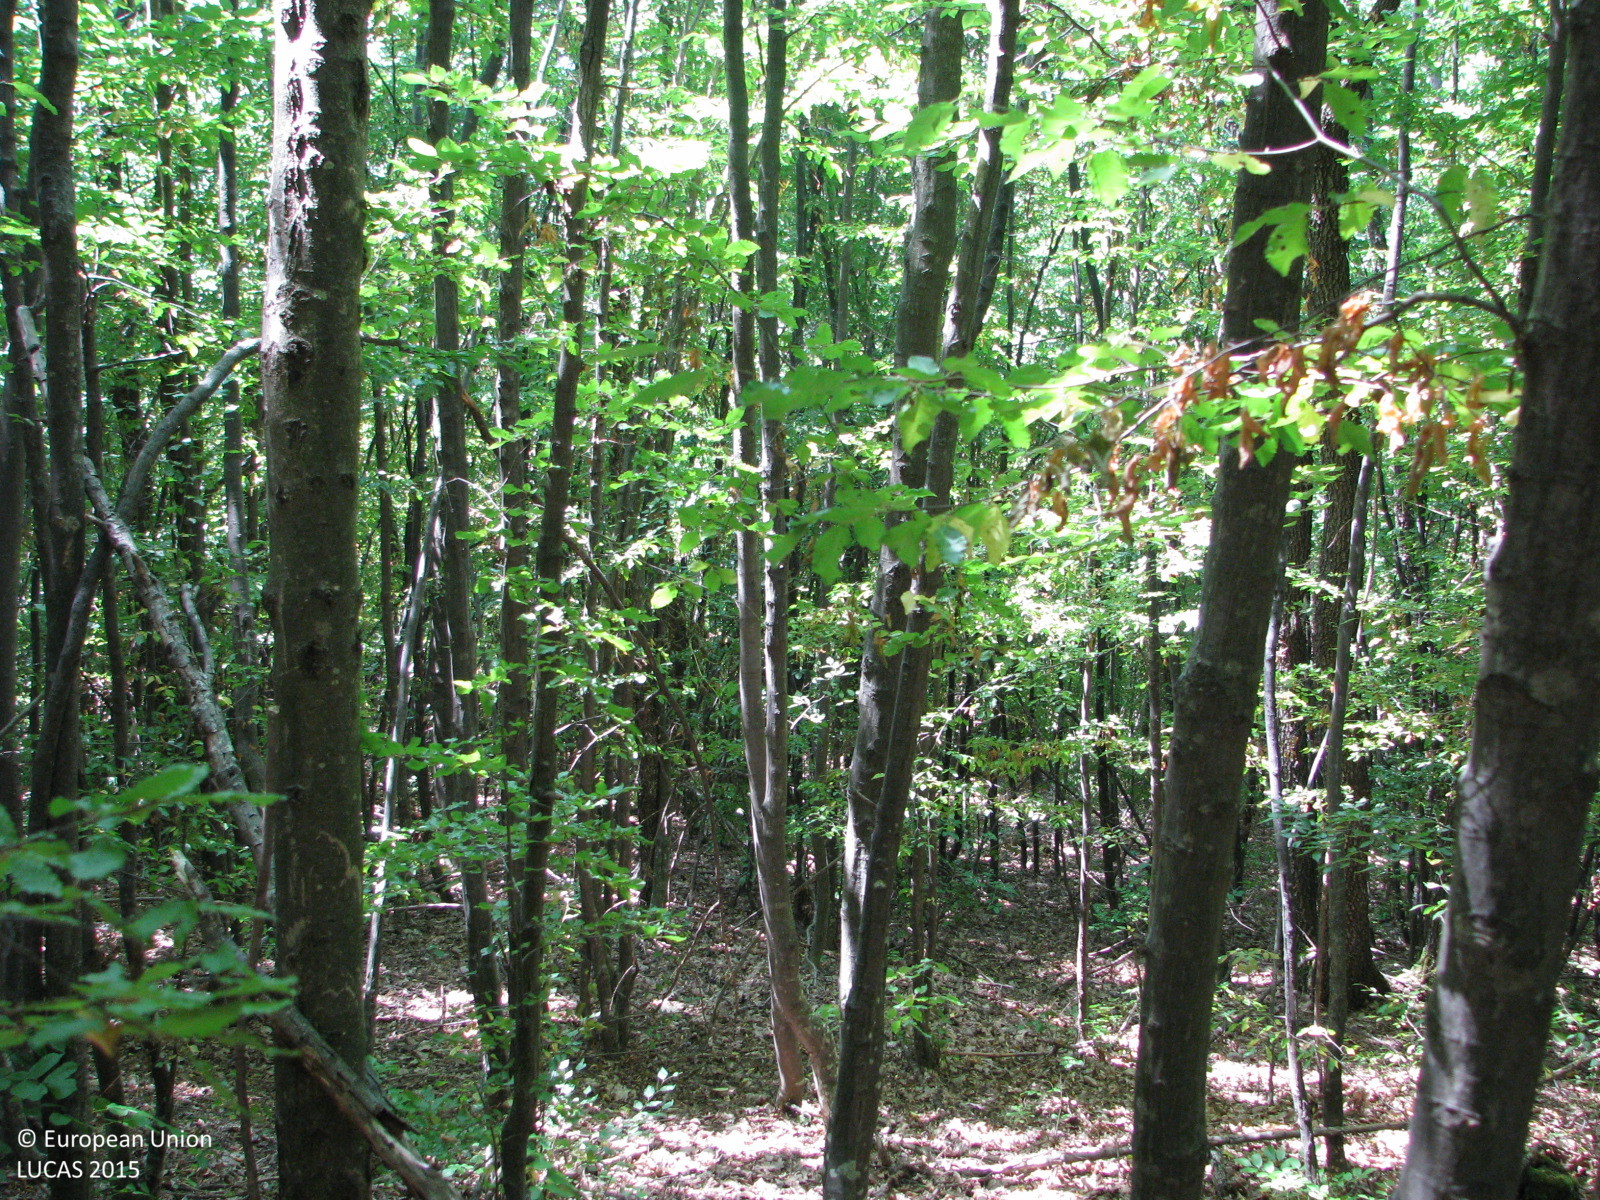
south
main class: Woodland
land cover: Broadleaved woodland
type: beech forest
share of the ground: > 75 %
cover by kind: broadleaved forest trees 85 %, unconsolidated bare surface 15 %
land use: Forestry
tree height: > 5 m
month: August
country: BG
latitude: 42.7582
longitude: 26.1804
